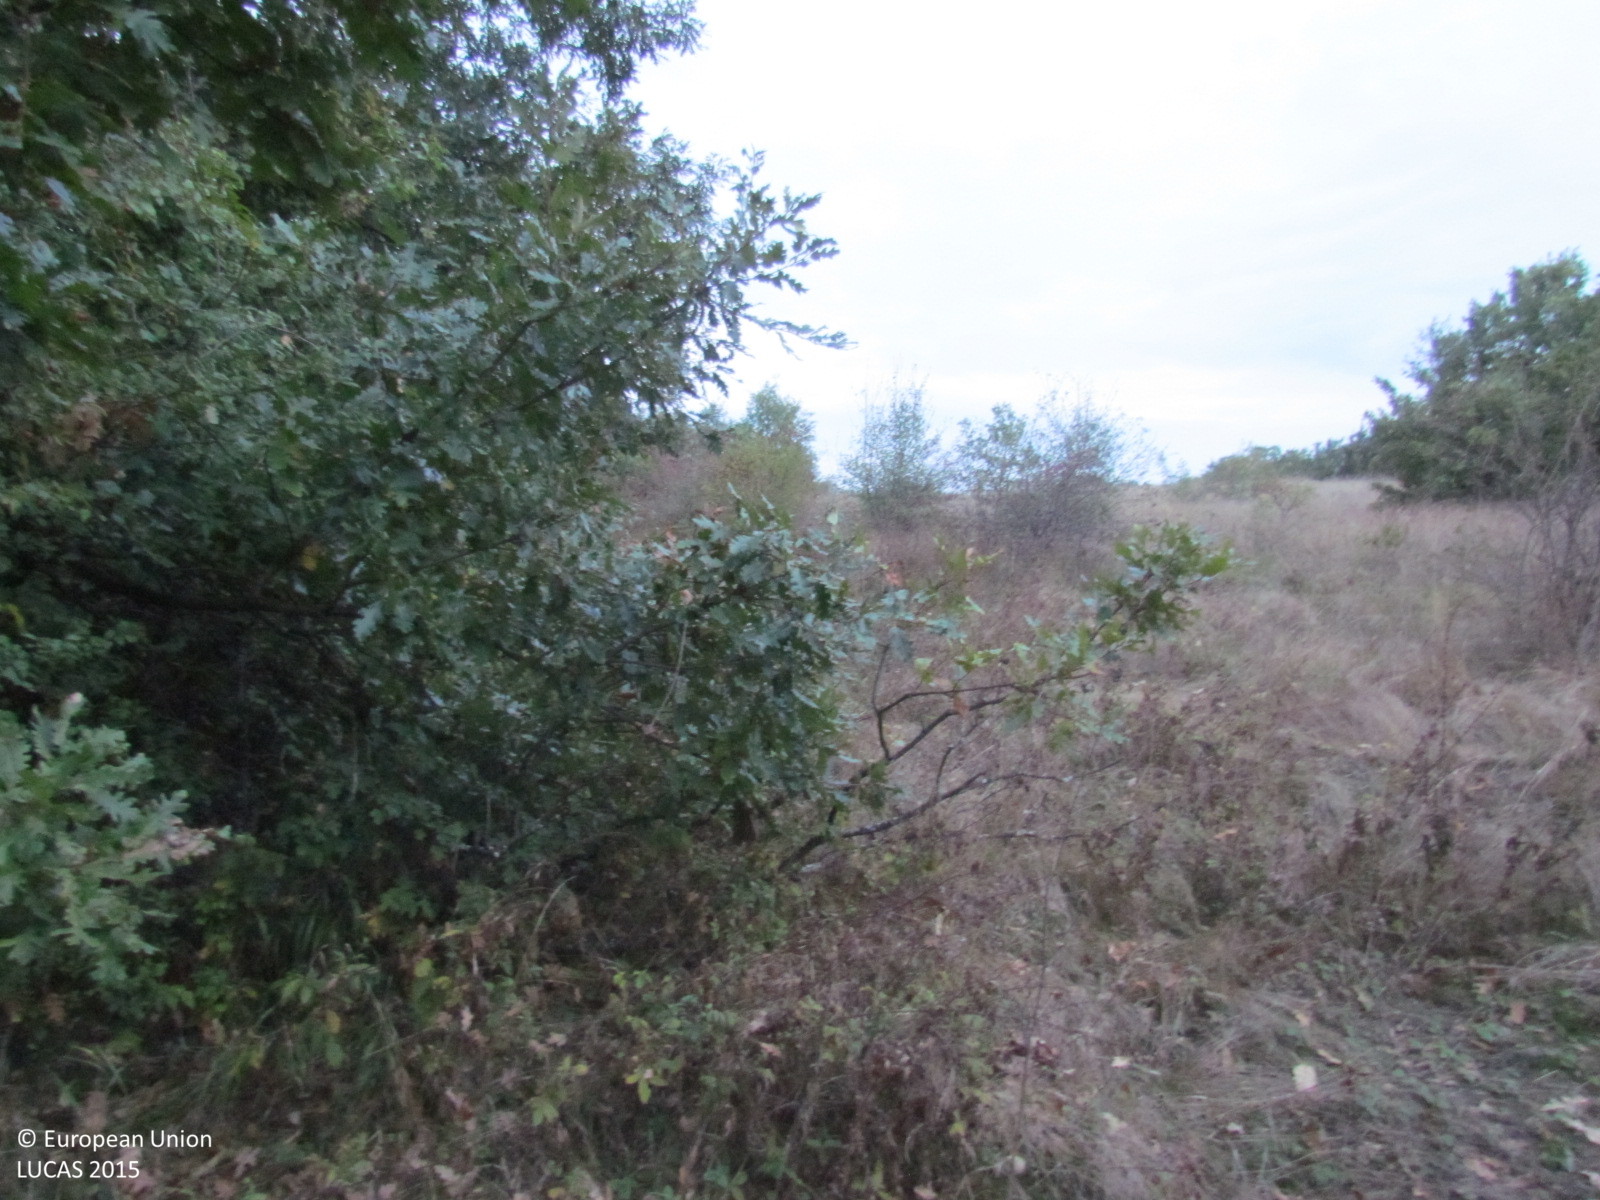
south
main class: Woodland
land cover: Broadleaved woodland
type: acidophilous oak and oak-birch forest
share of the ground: > 75 %
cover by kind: broadleaved forest trees 80 %, shrubs 10 %, herbaceous plants 10 %
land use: Forestry
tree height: > 5 m
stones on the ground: < 10 %
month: October
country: BG
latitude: 42.6989
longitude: 26.7643
